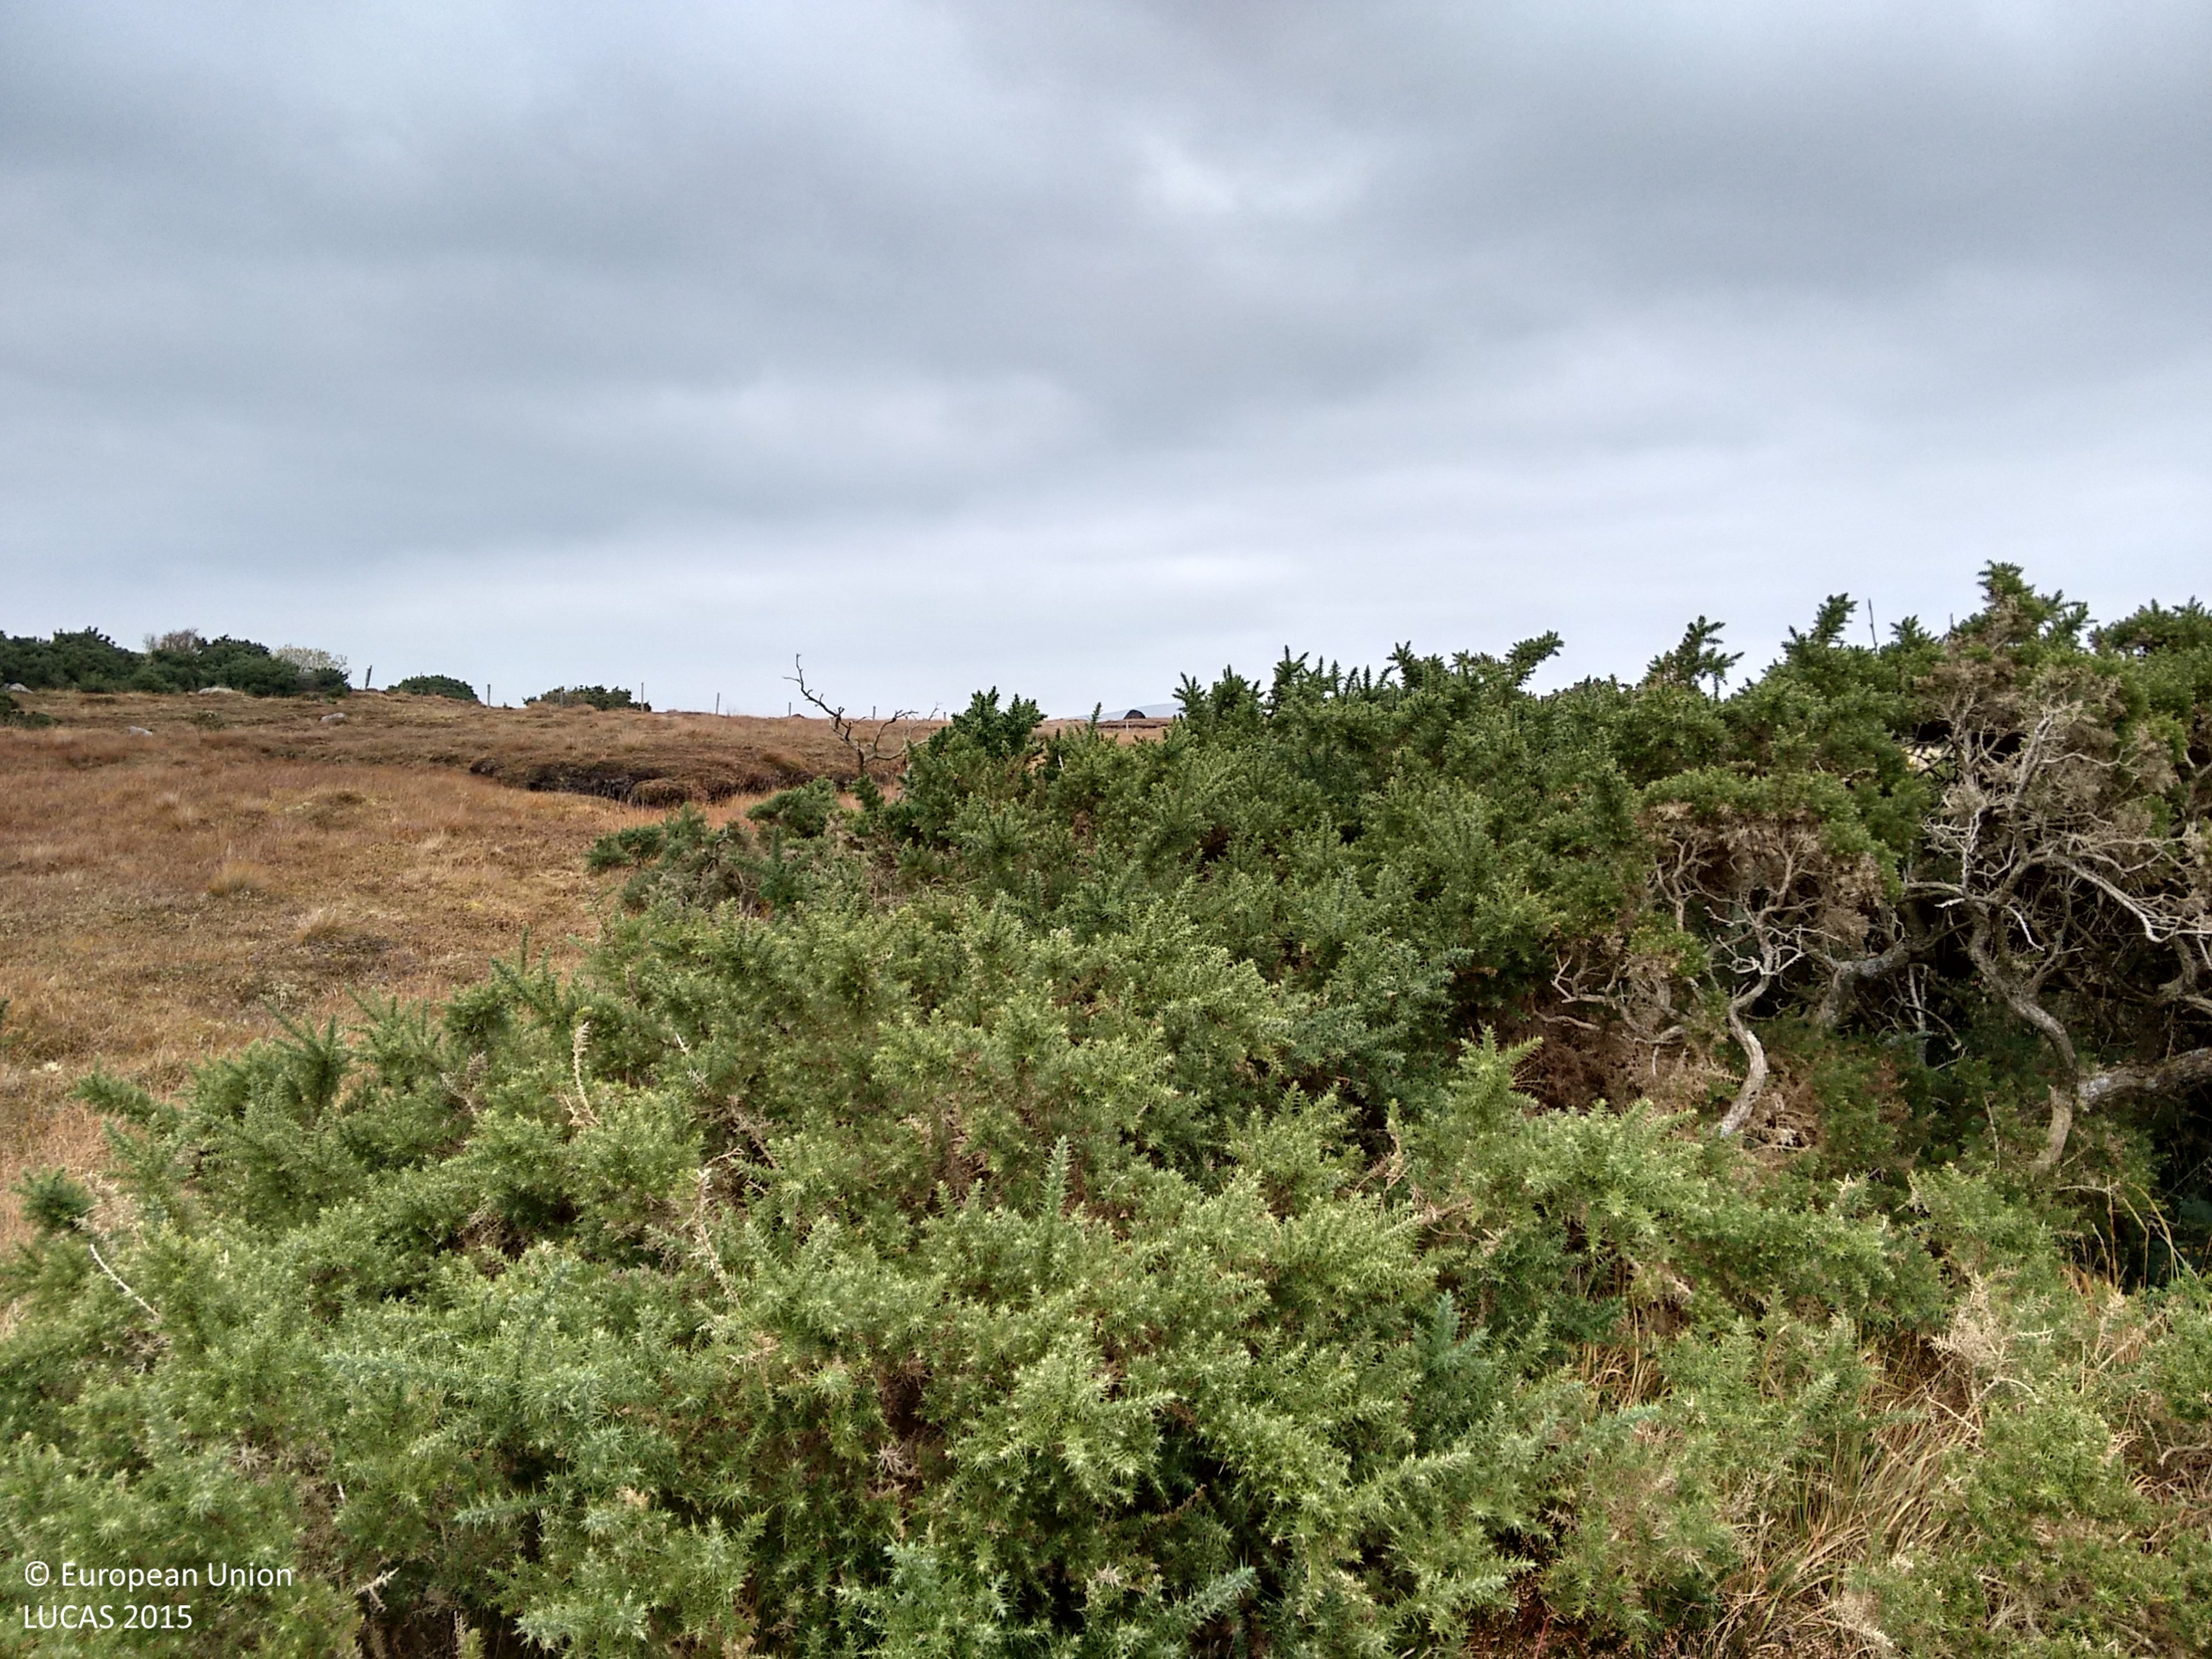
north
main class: Shrubland
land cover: Shrubland without tree cover
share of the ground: > 75 %
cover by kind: shrubs 40 %, herbaceous plants 40 %, lichens and mosses 20 %
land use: Agriculture (excluding fallow land and kitchen gardens)
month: November
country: IE
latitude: 55.0797
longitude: -8.2728
